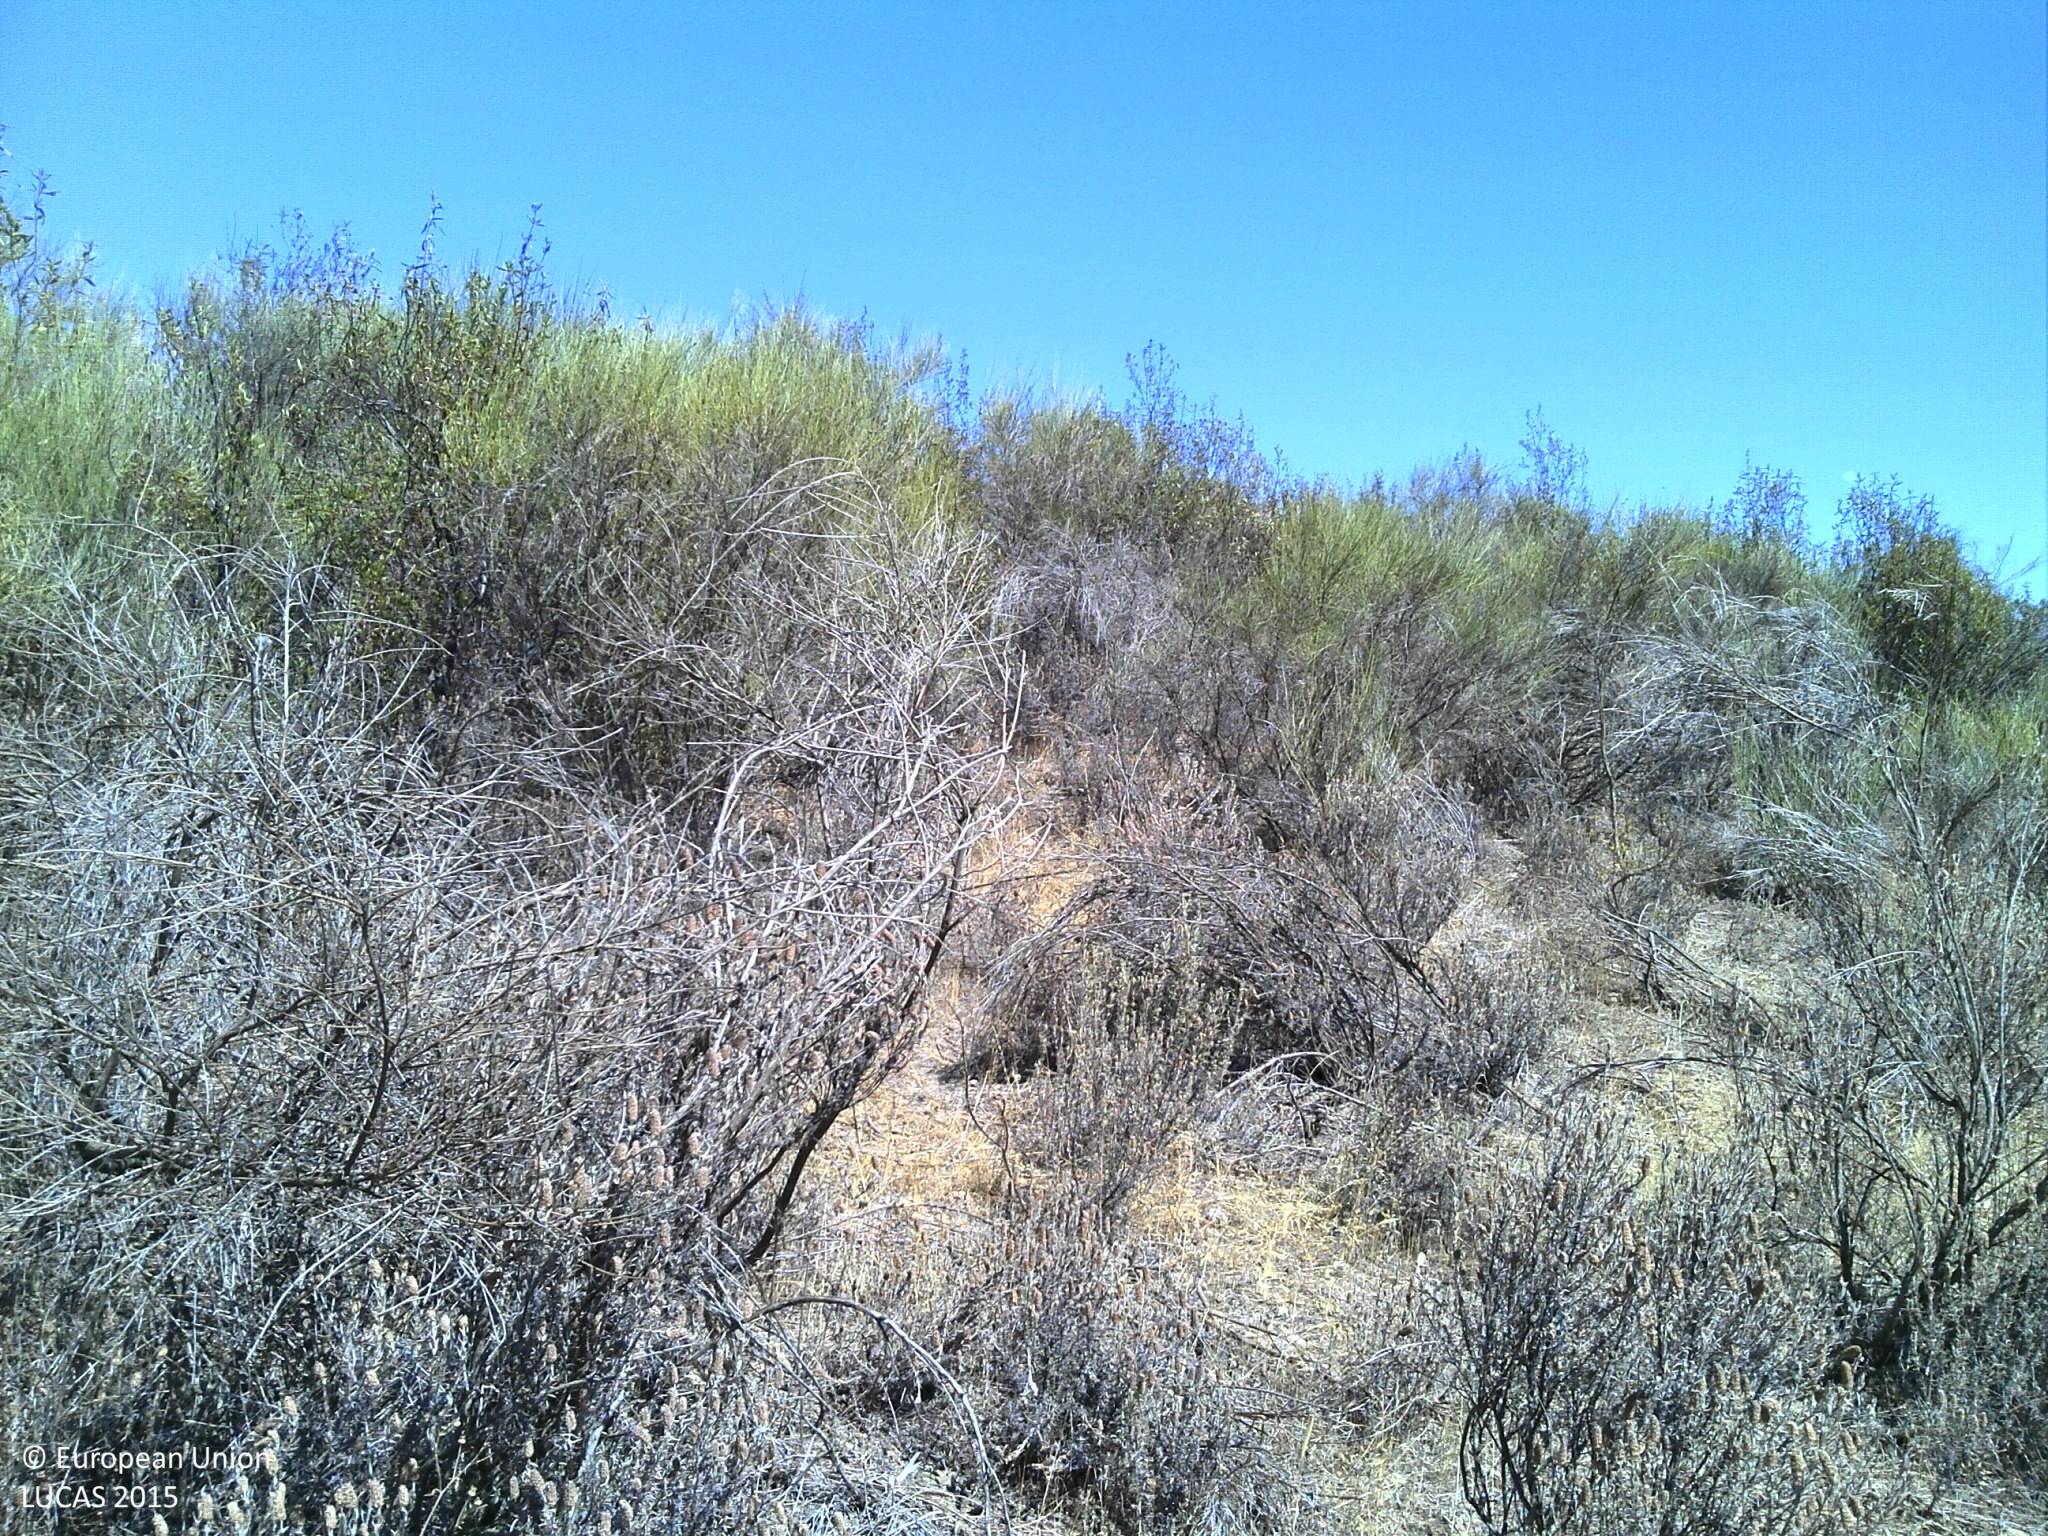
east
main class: Shrubland
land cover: Shrubland without tree cover
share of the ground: > 75 %
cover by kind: shrubs 95 %, unconsolidated bare surface 5 %
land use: Semi-natural and natural areas not in use
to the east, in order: Shrubland without tree cover
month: August
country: PT
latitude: 39.6118
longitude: -7.5565
